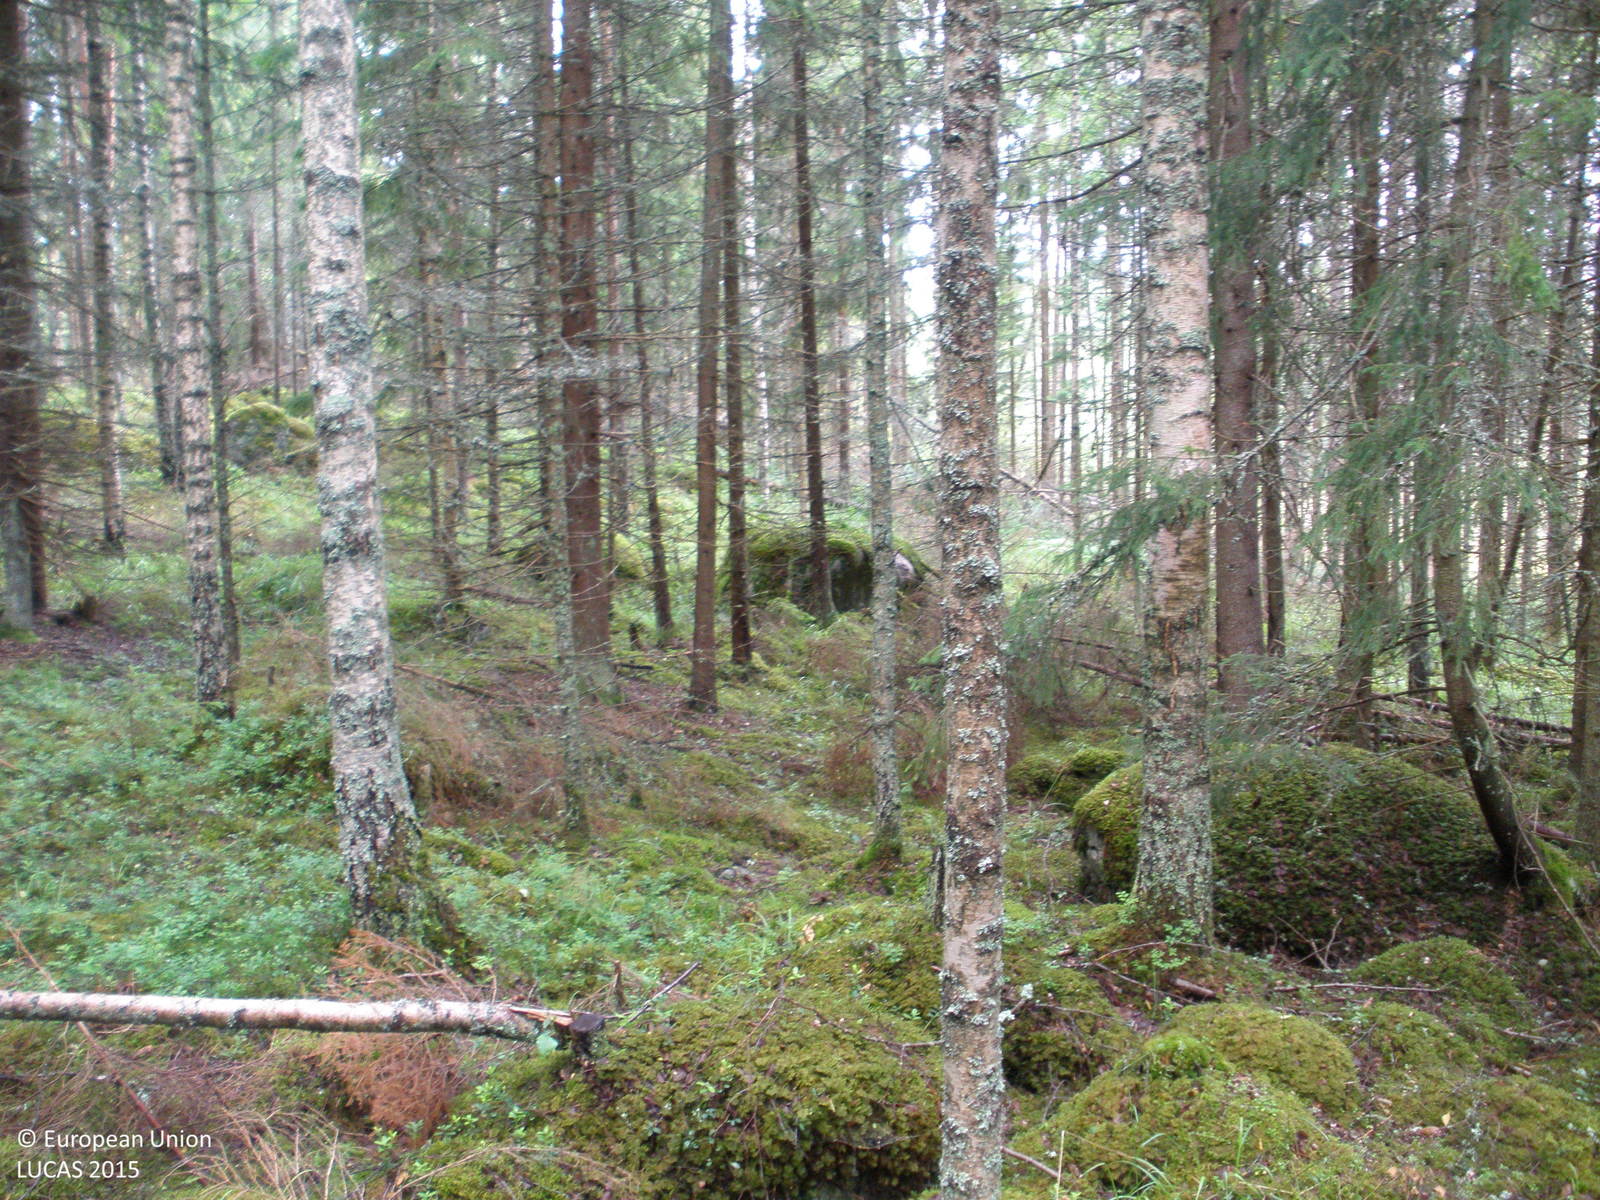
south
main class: Woodland
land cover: Spruce dominated mixed woodland
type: boreal forest
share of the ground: > 75 %
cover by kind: coniferous forest trees 60 %, broadleaved forest trees 30 %, herbaceous plants 5 %, lichens and mosses 5 %
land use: Forestry
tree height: > 5 m
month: July
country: FI
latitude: 61.4257
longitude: 23.1751
